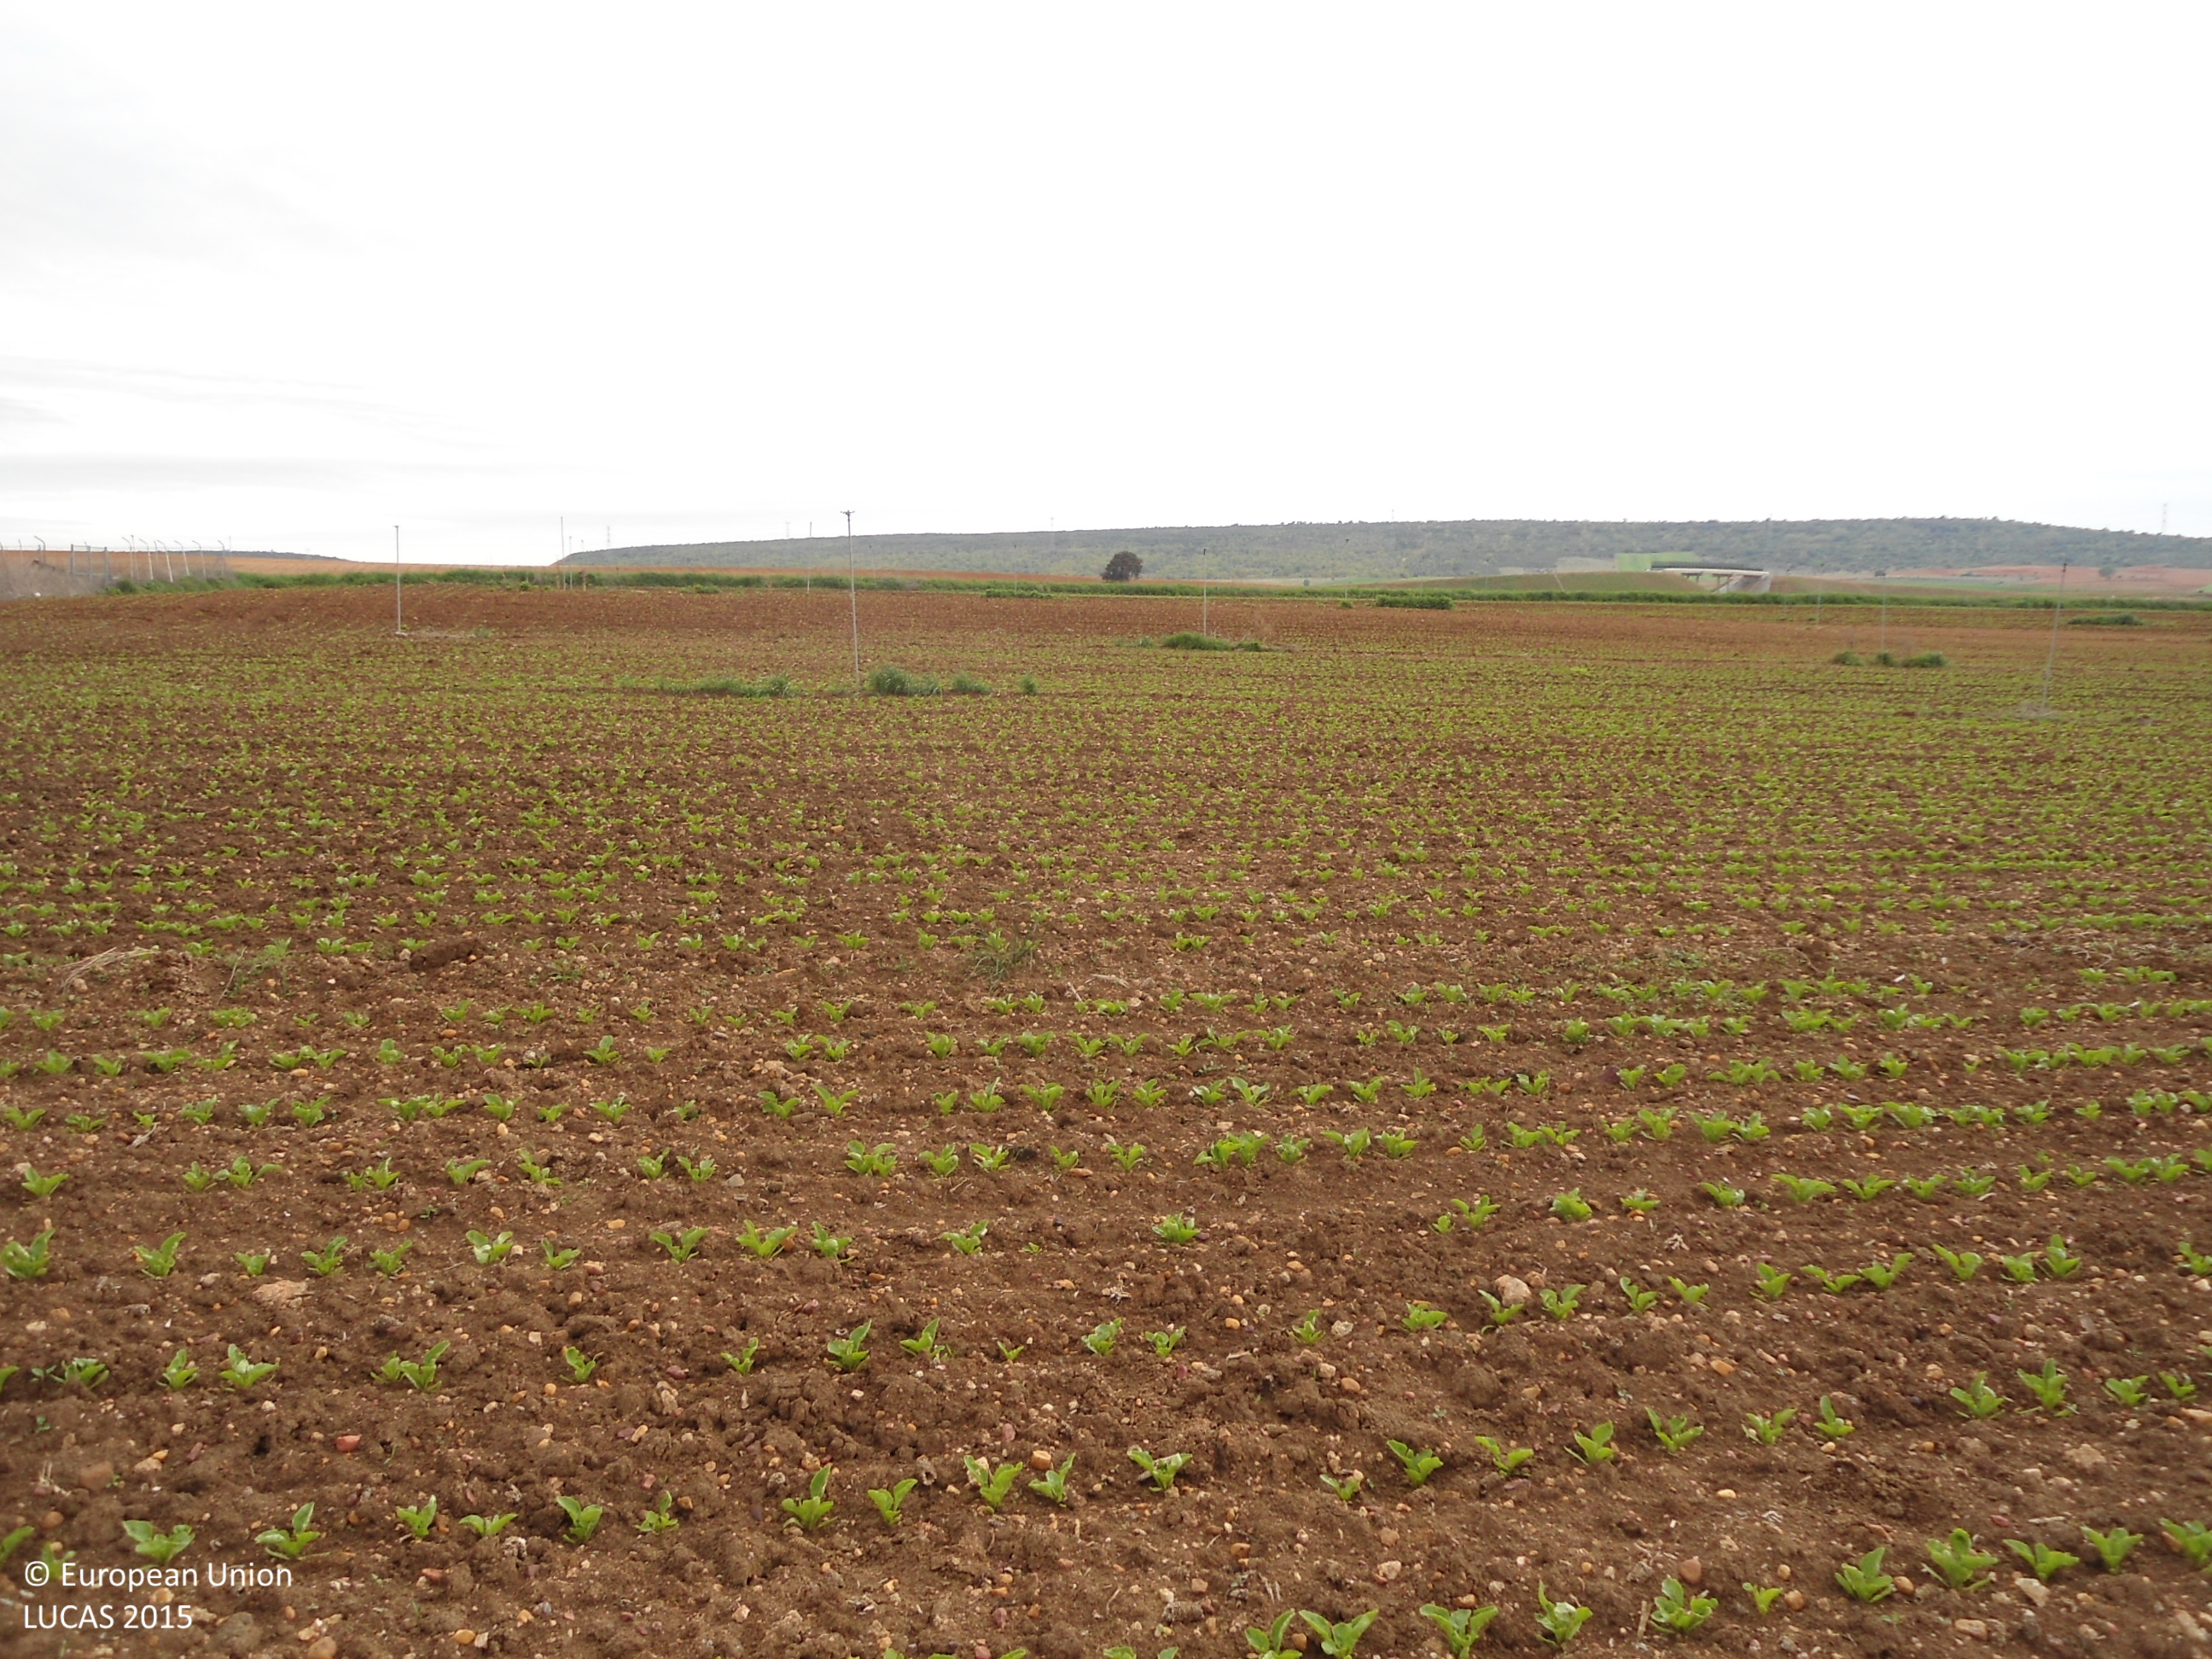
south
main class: Cropland
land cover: Sugar beet
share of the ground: 25 - 50 %
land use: Agriculture (excluding fallow land and kitchen gardens)
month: May
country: ES
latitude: 41.7800
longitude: -5.8660
